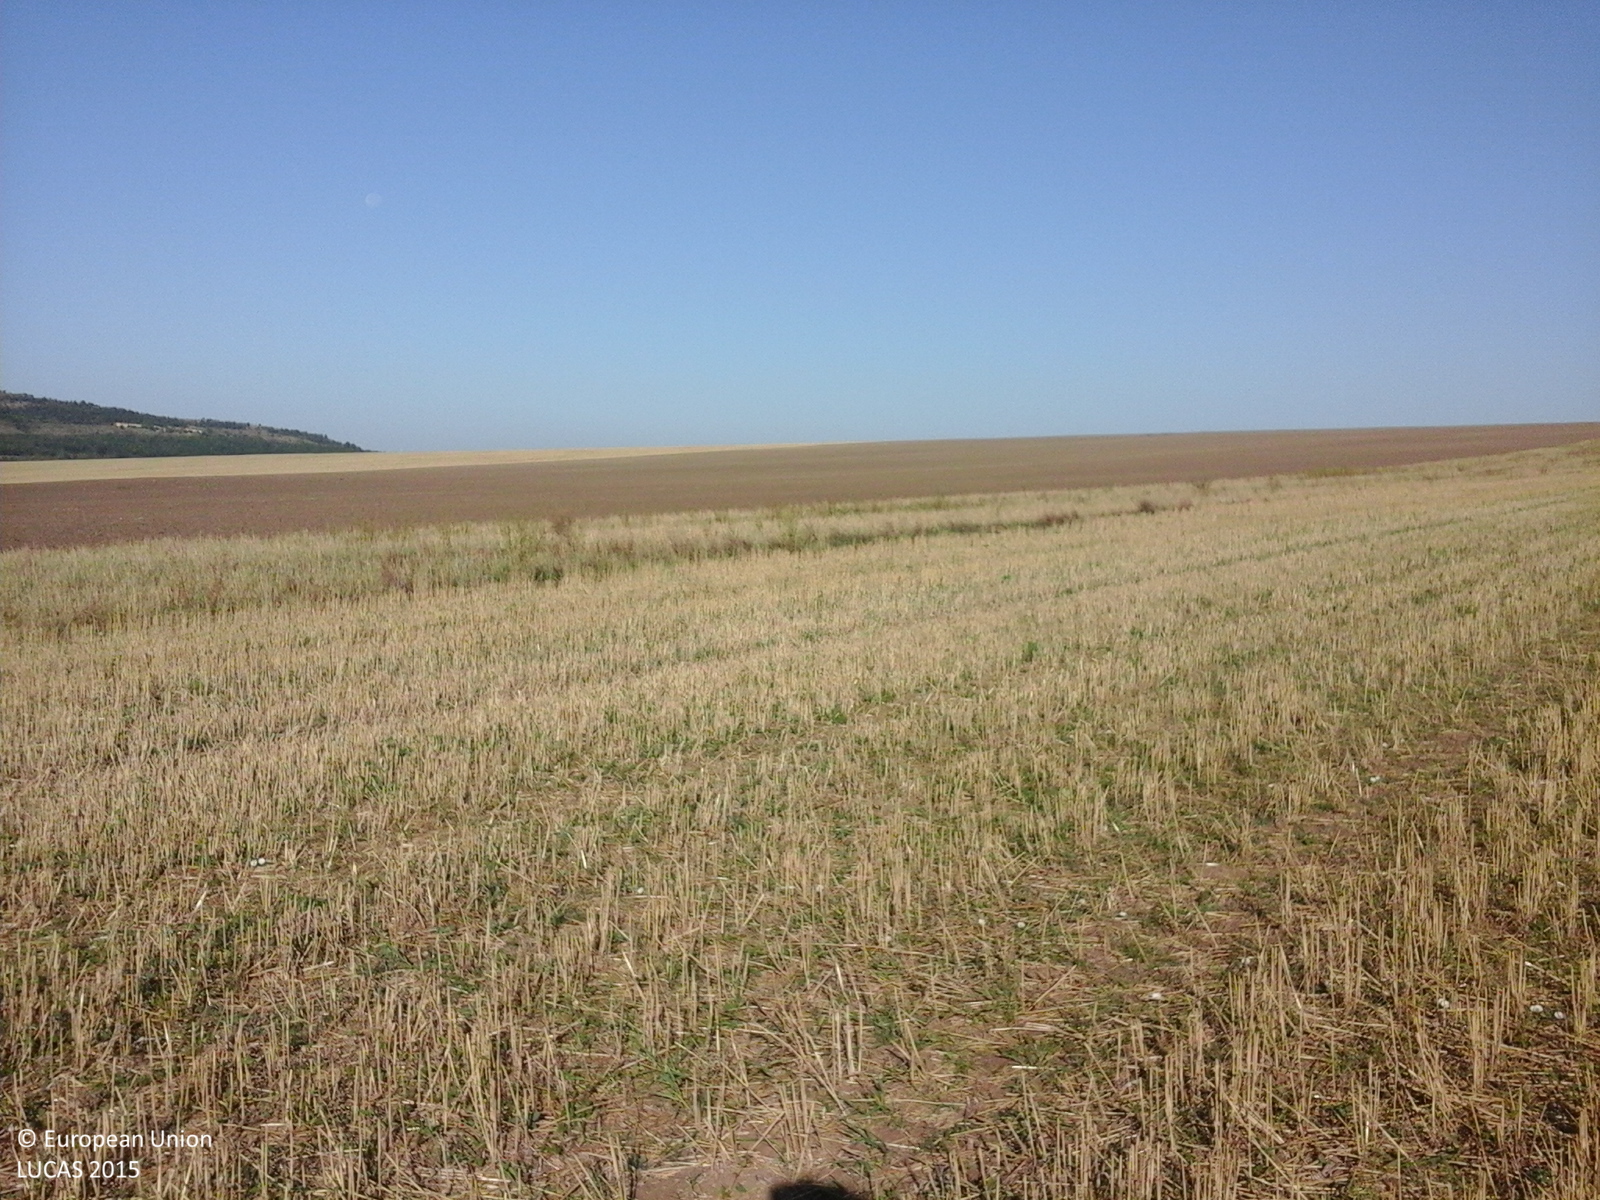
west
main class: Cropland
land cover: Common wheat
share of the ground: 50 - 75 %
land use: Agriculture (excluding fallow land and kitchen gardens)
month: August
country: RO
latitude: 44.4760
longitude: 28.5163
